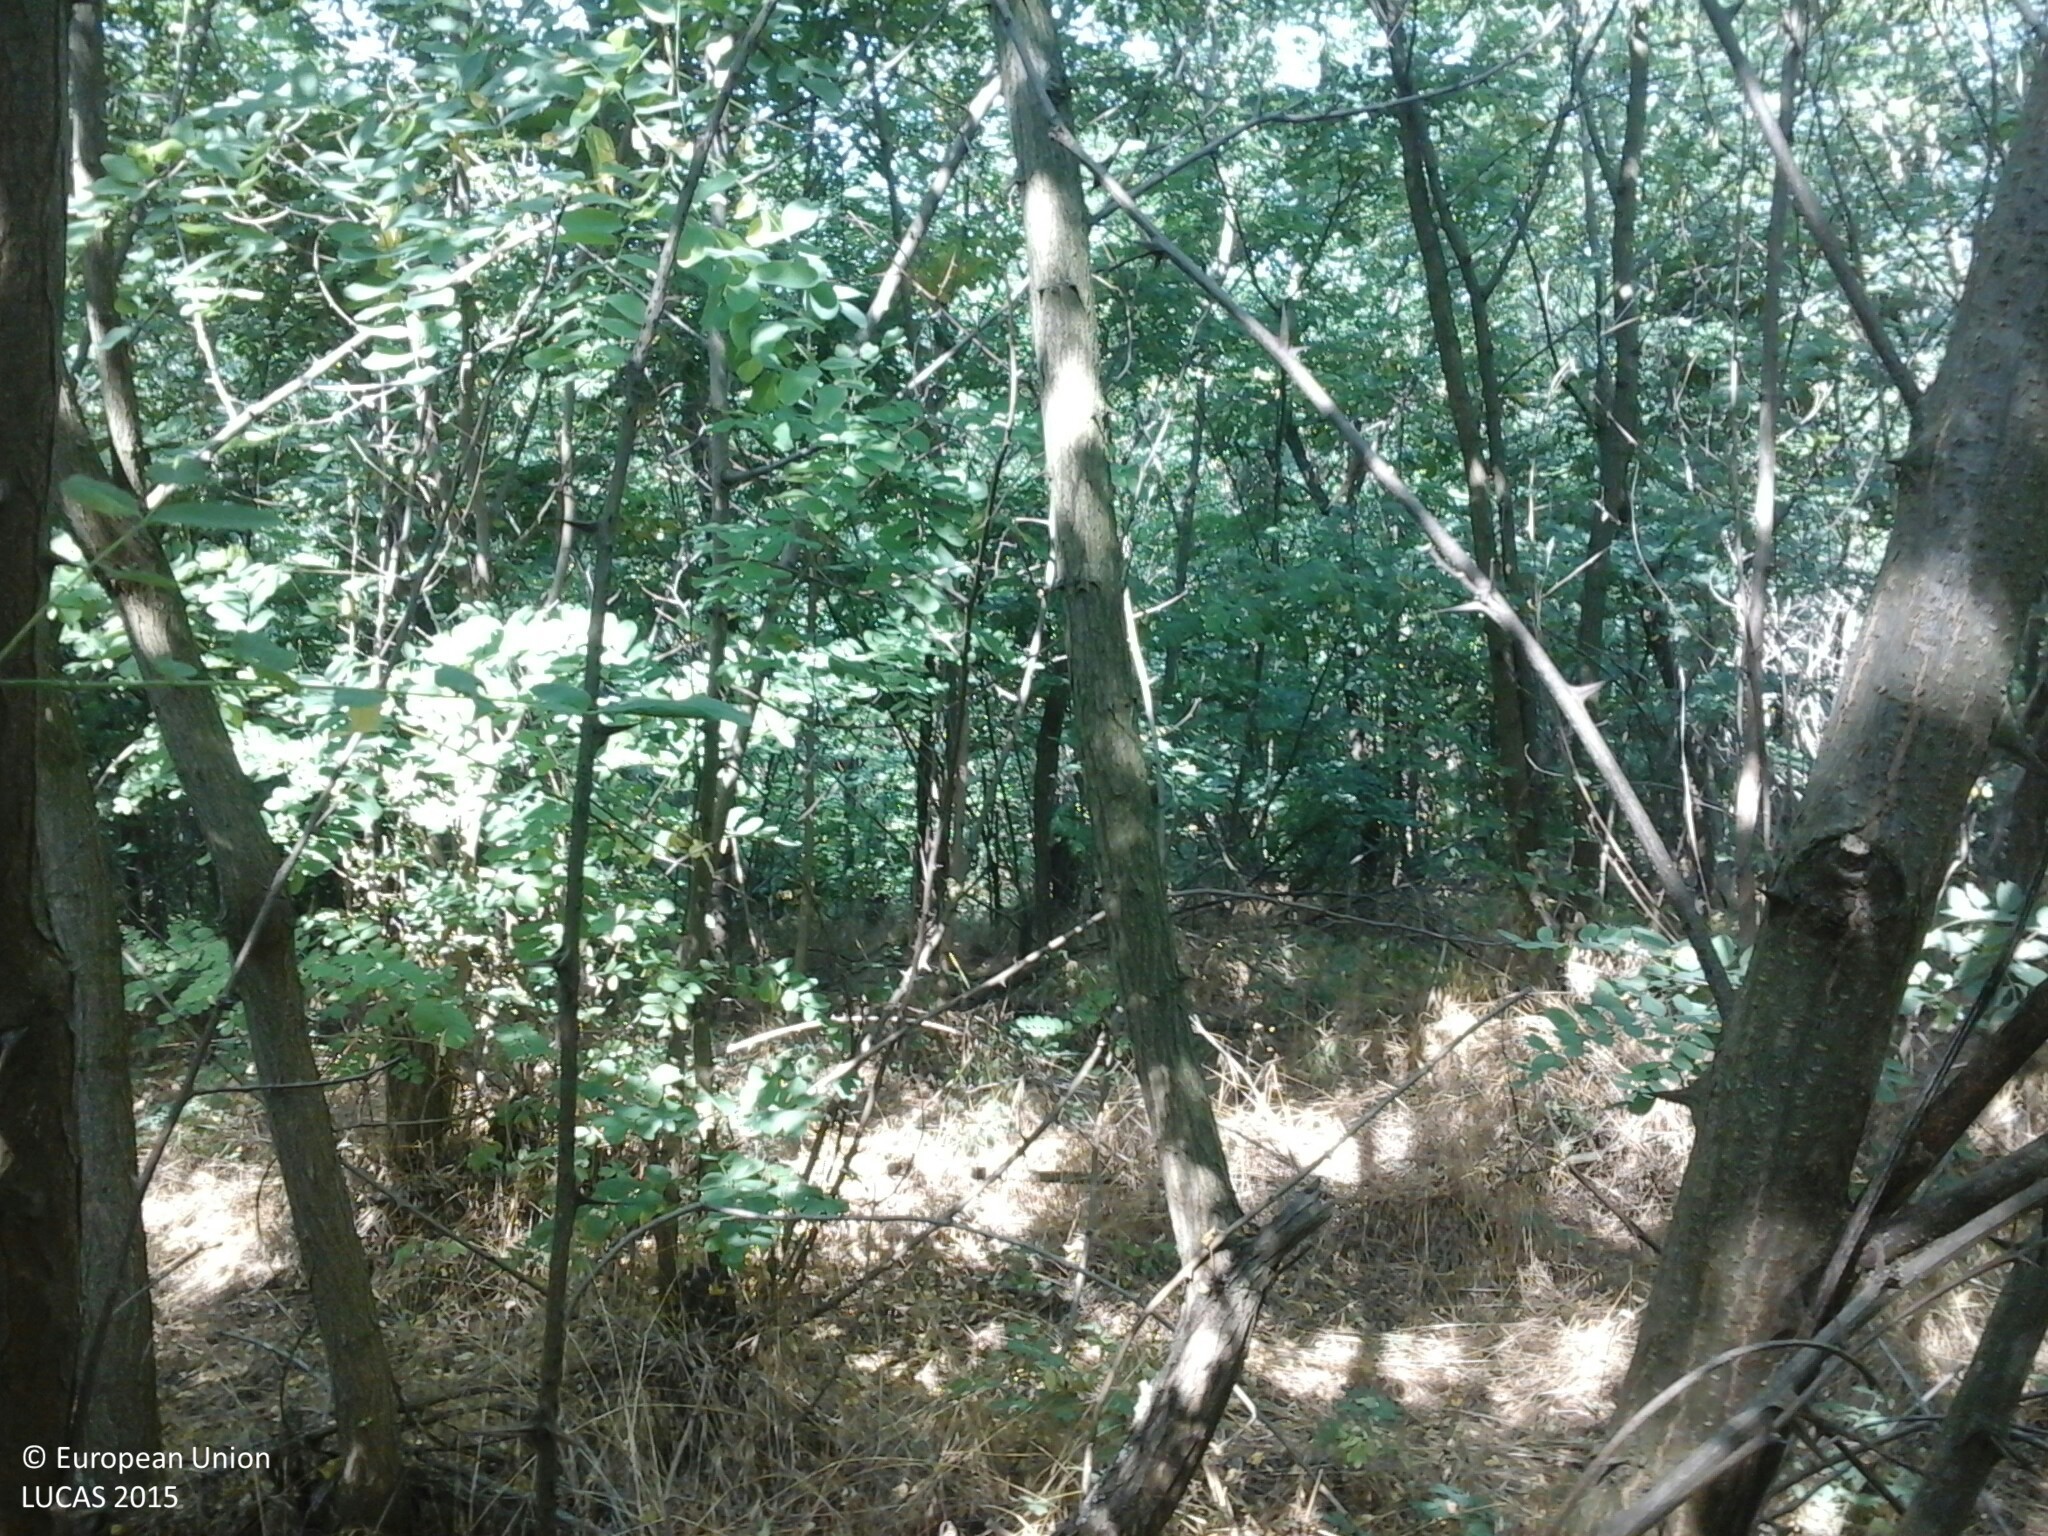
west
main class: Woodland
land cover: Broadleaved woodland
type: exotic forest
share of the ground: > 75 %
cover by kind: broadleaved forest trees 100 %
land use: Forestry
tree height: > 5 m
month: July
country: HU
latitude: 48.2713
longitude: 22.1955
